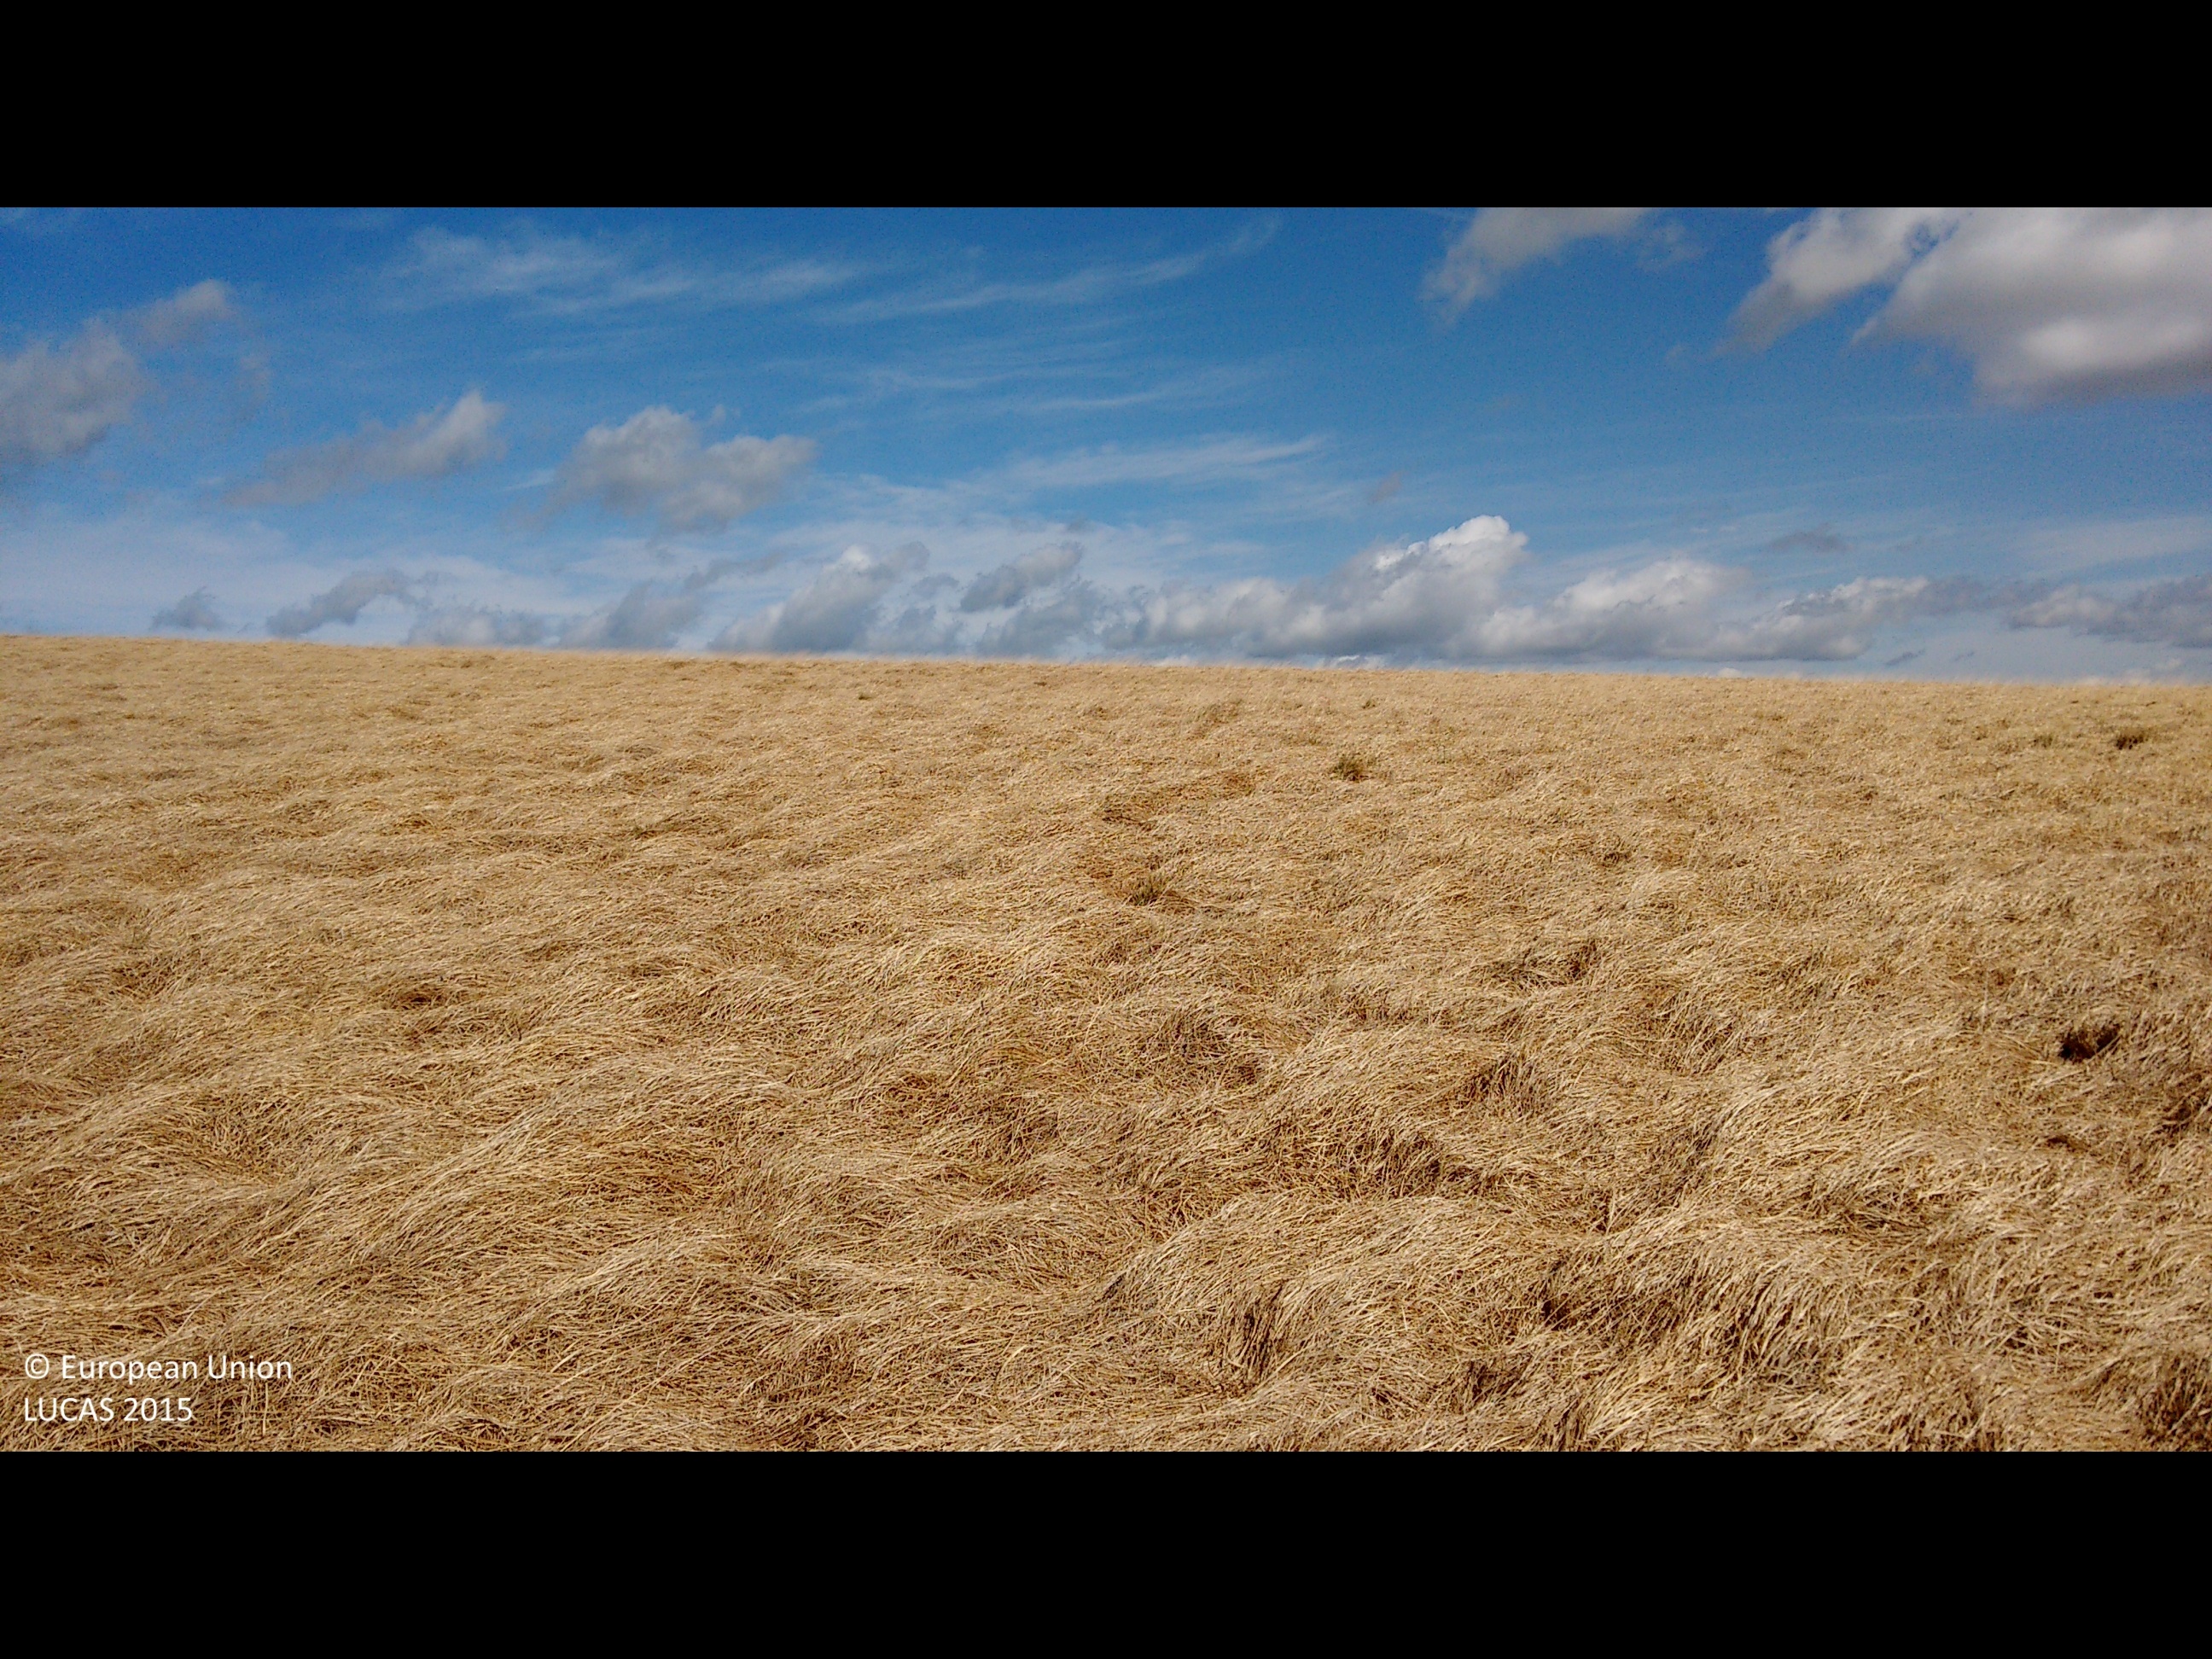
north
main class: Grassland
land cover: Grassland without tree/shrub cover
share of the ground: > 75 %
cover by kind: herbaceous plants 100 %
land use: Agriculture (excluding fallow land and kitchen gardens)
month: May
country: GB
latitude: 53.6416
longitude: -2.5142
